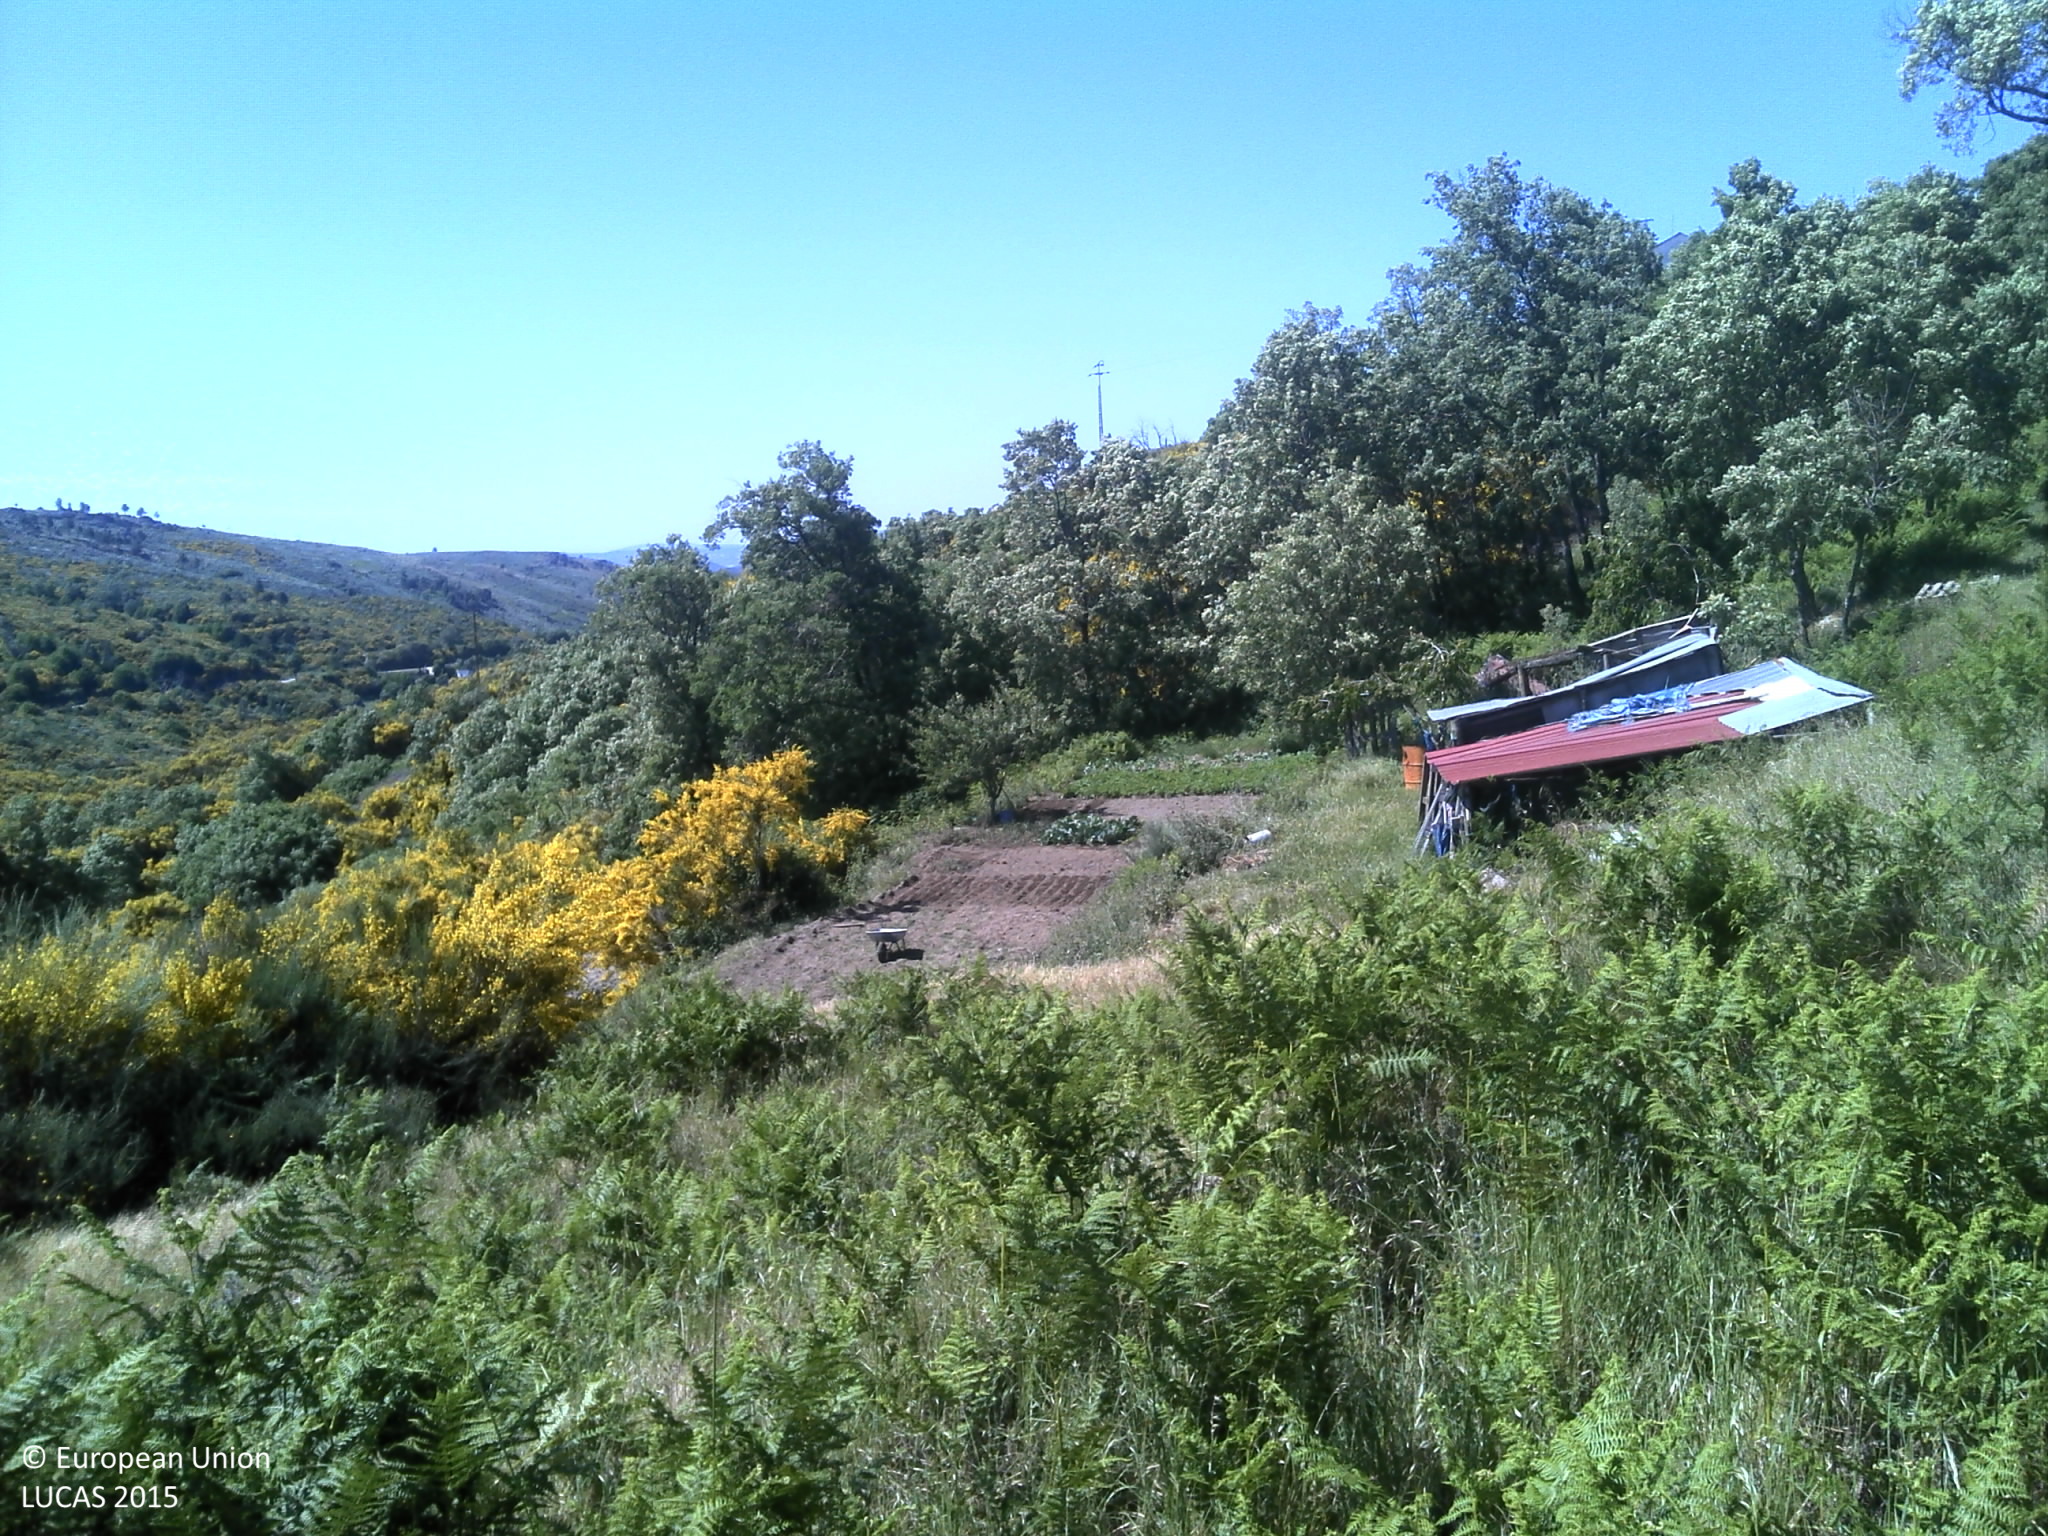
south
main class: Shrubland
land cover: Shrubland without tree cover
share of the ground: 50 - 75 %
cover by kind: shrubs 50 %, herbaceous plants 40 %, unconsolidated bare surface 10 %
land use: Semi-natural and natural areas not in use
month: May
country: PT
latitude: 40.4933
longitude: -7.2722
